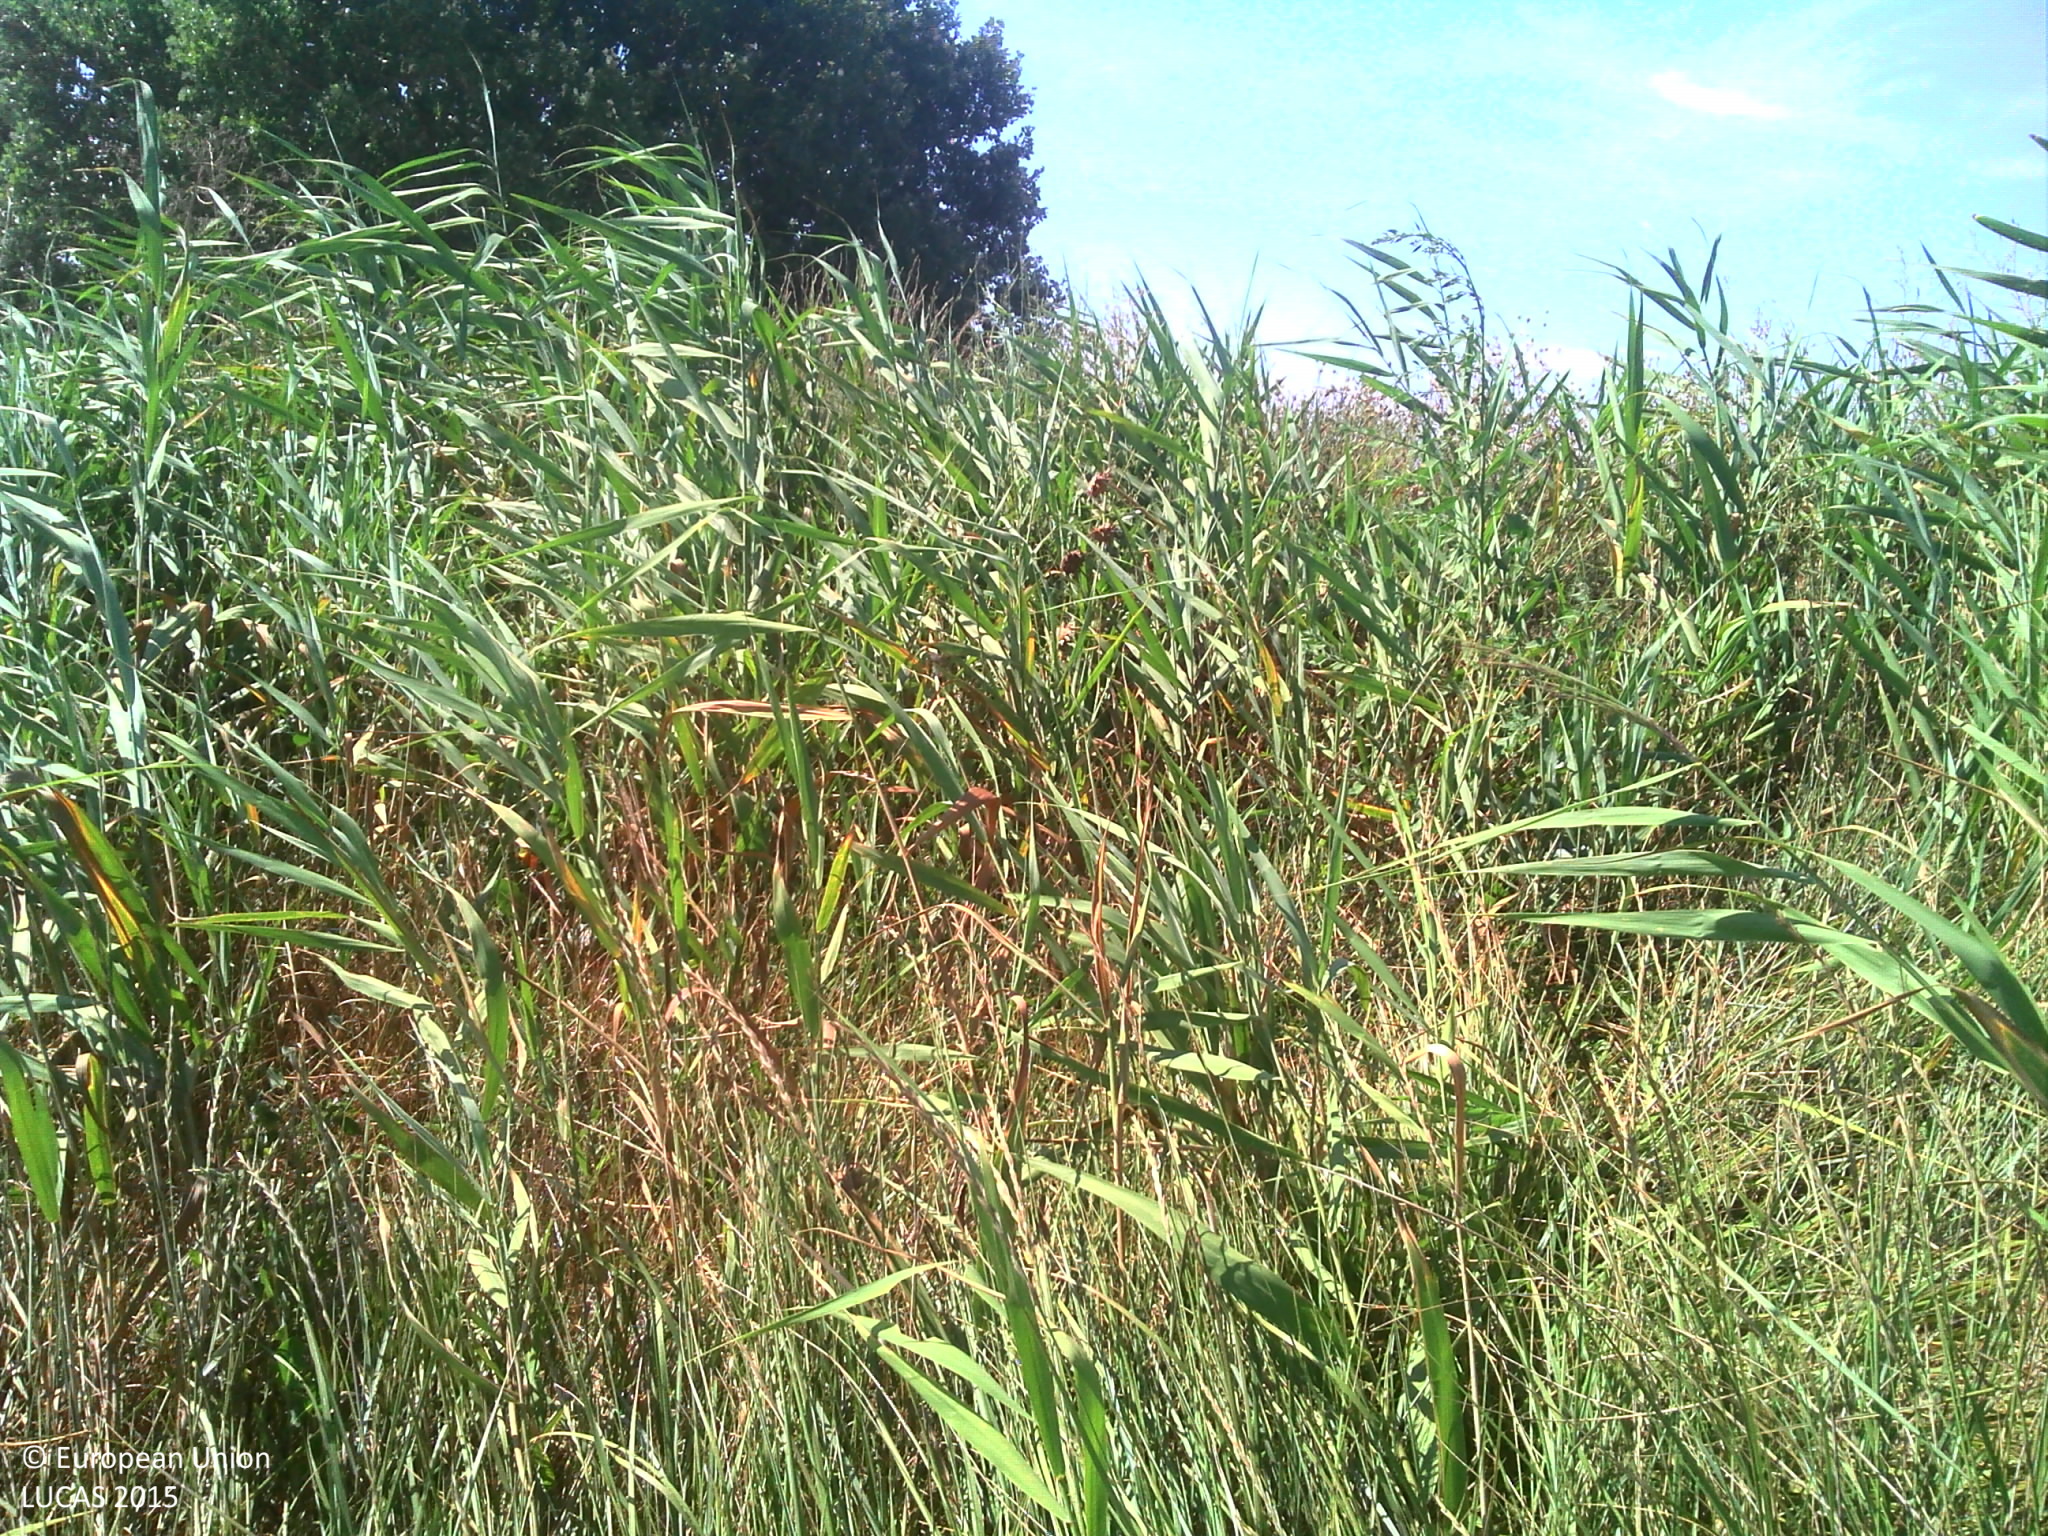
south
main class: Cropland
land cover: Other cereals
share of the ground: > 75 %
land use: Agriculture (excluding fallow land and kitchen gardens)
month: July
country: FR
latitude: 43.5823
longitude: 4.6969
